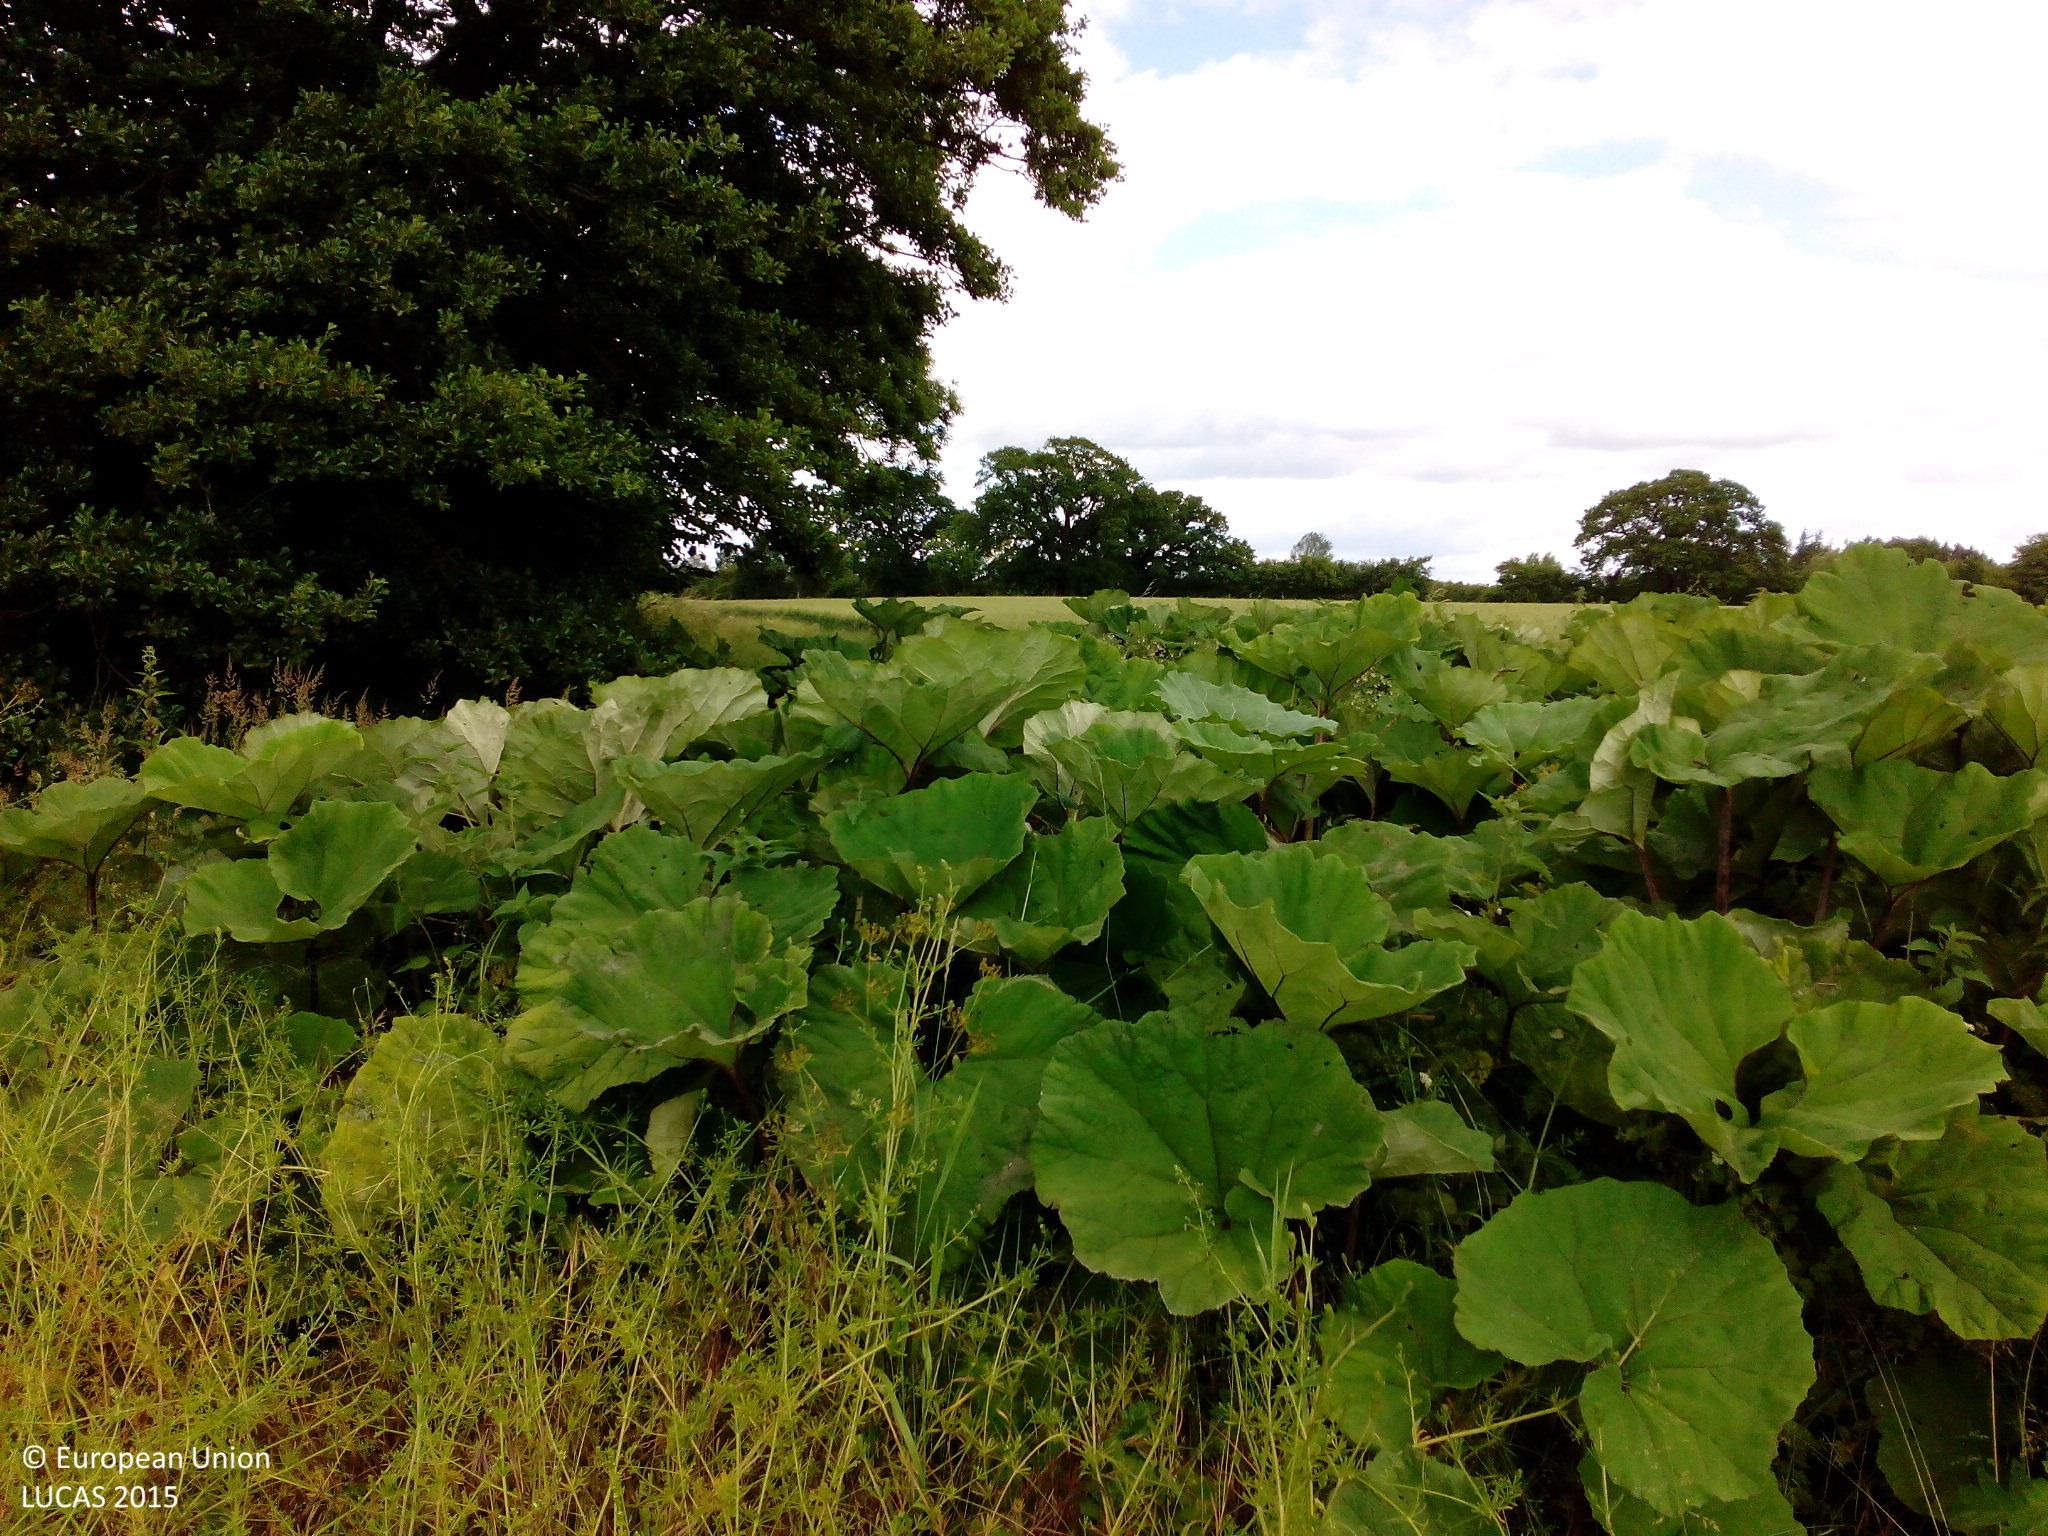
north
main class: Grassland
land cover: Spontaneously vegetated surfaces
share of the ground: > 75 %
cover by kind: herbaceous plants 100 %
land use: Agriculture (excluding fallow land and kitchen gardens)
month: July
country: DK
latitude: 55.2172
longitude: 12.1204
